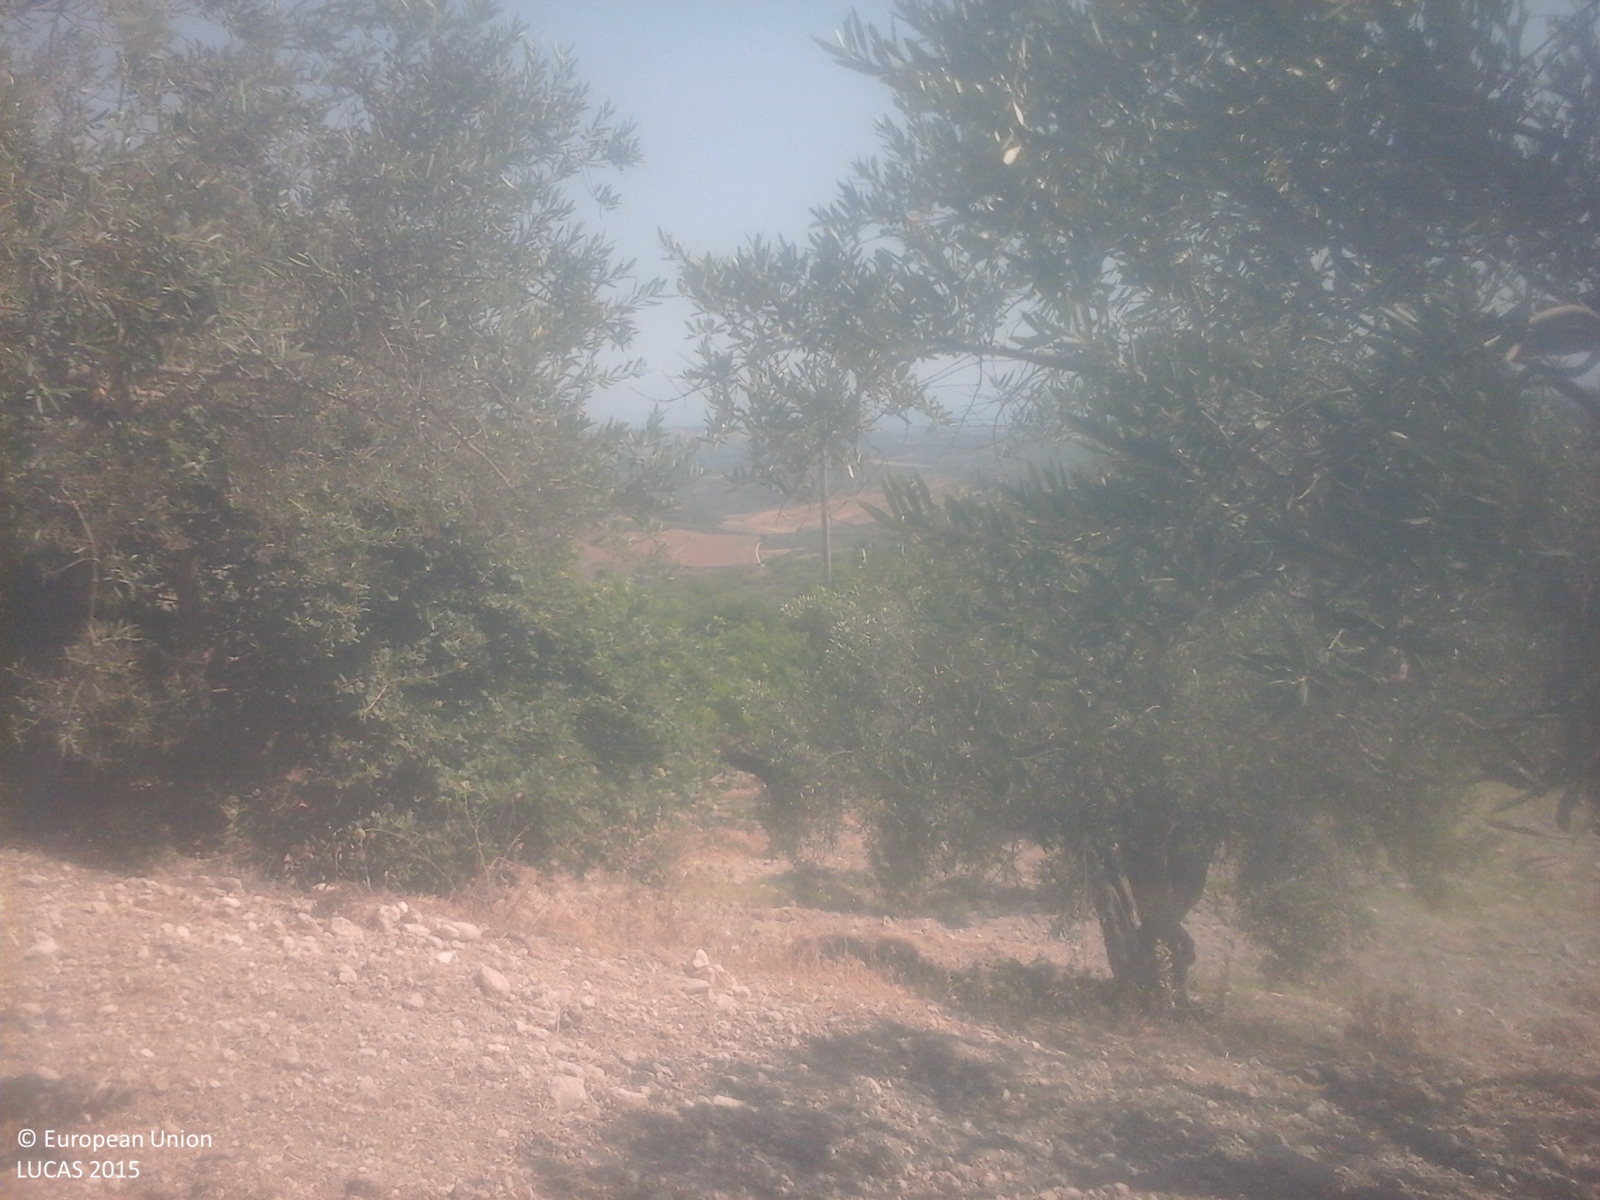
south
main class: Cropland
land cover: Olive groves
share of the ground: 25 - 50 %
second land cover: Other bare soil
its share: > 75 %
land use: Agriculture (excluding fallow land and kitchen gardens)
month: July
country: IT
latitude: 37.5657
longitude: 13.2248
